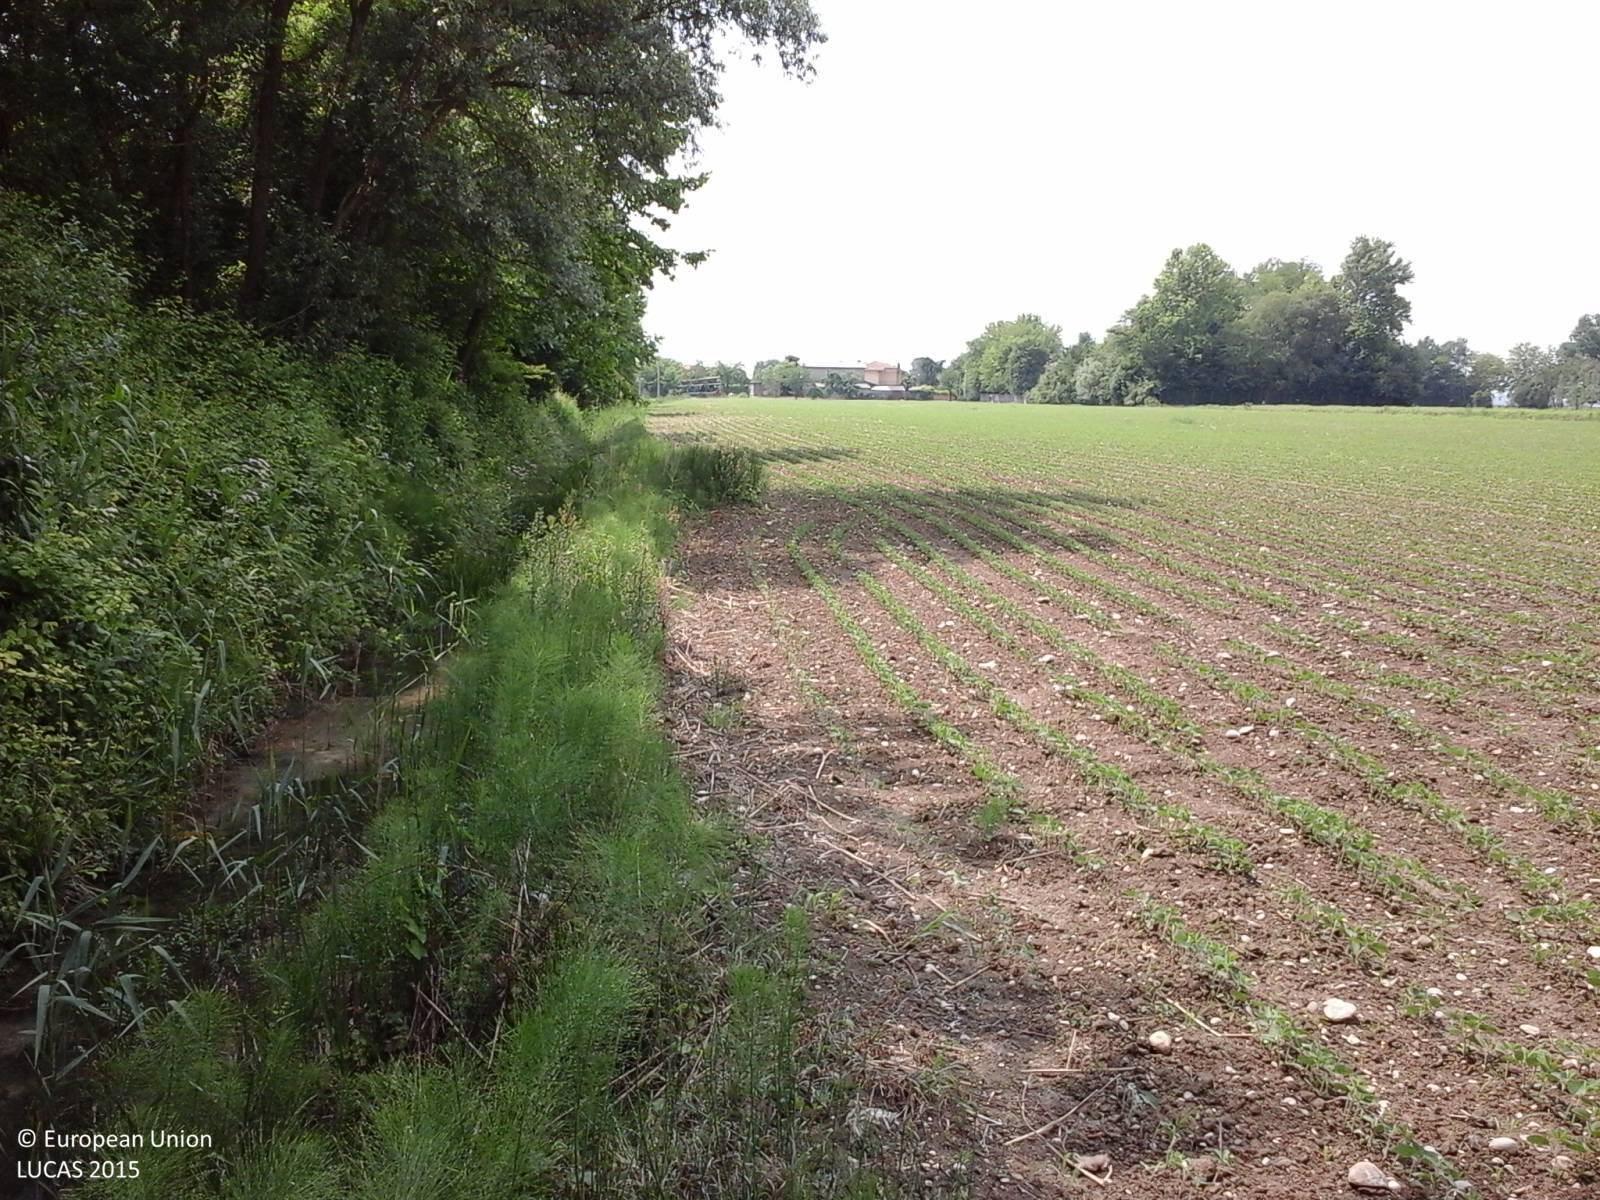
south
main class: Woodland
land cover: Broadleaved woodland
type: thermophilous deciduous forest
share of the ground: > 75 %
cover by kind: broadleaved forest trees 90 %, shrubs 10 %
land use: Forestry
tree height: > 5 m
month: May
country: IT
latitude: 45.8682
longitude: 13.2810
